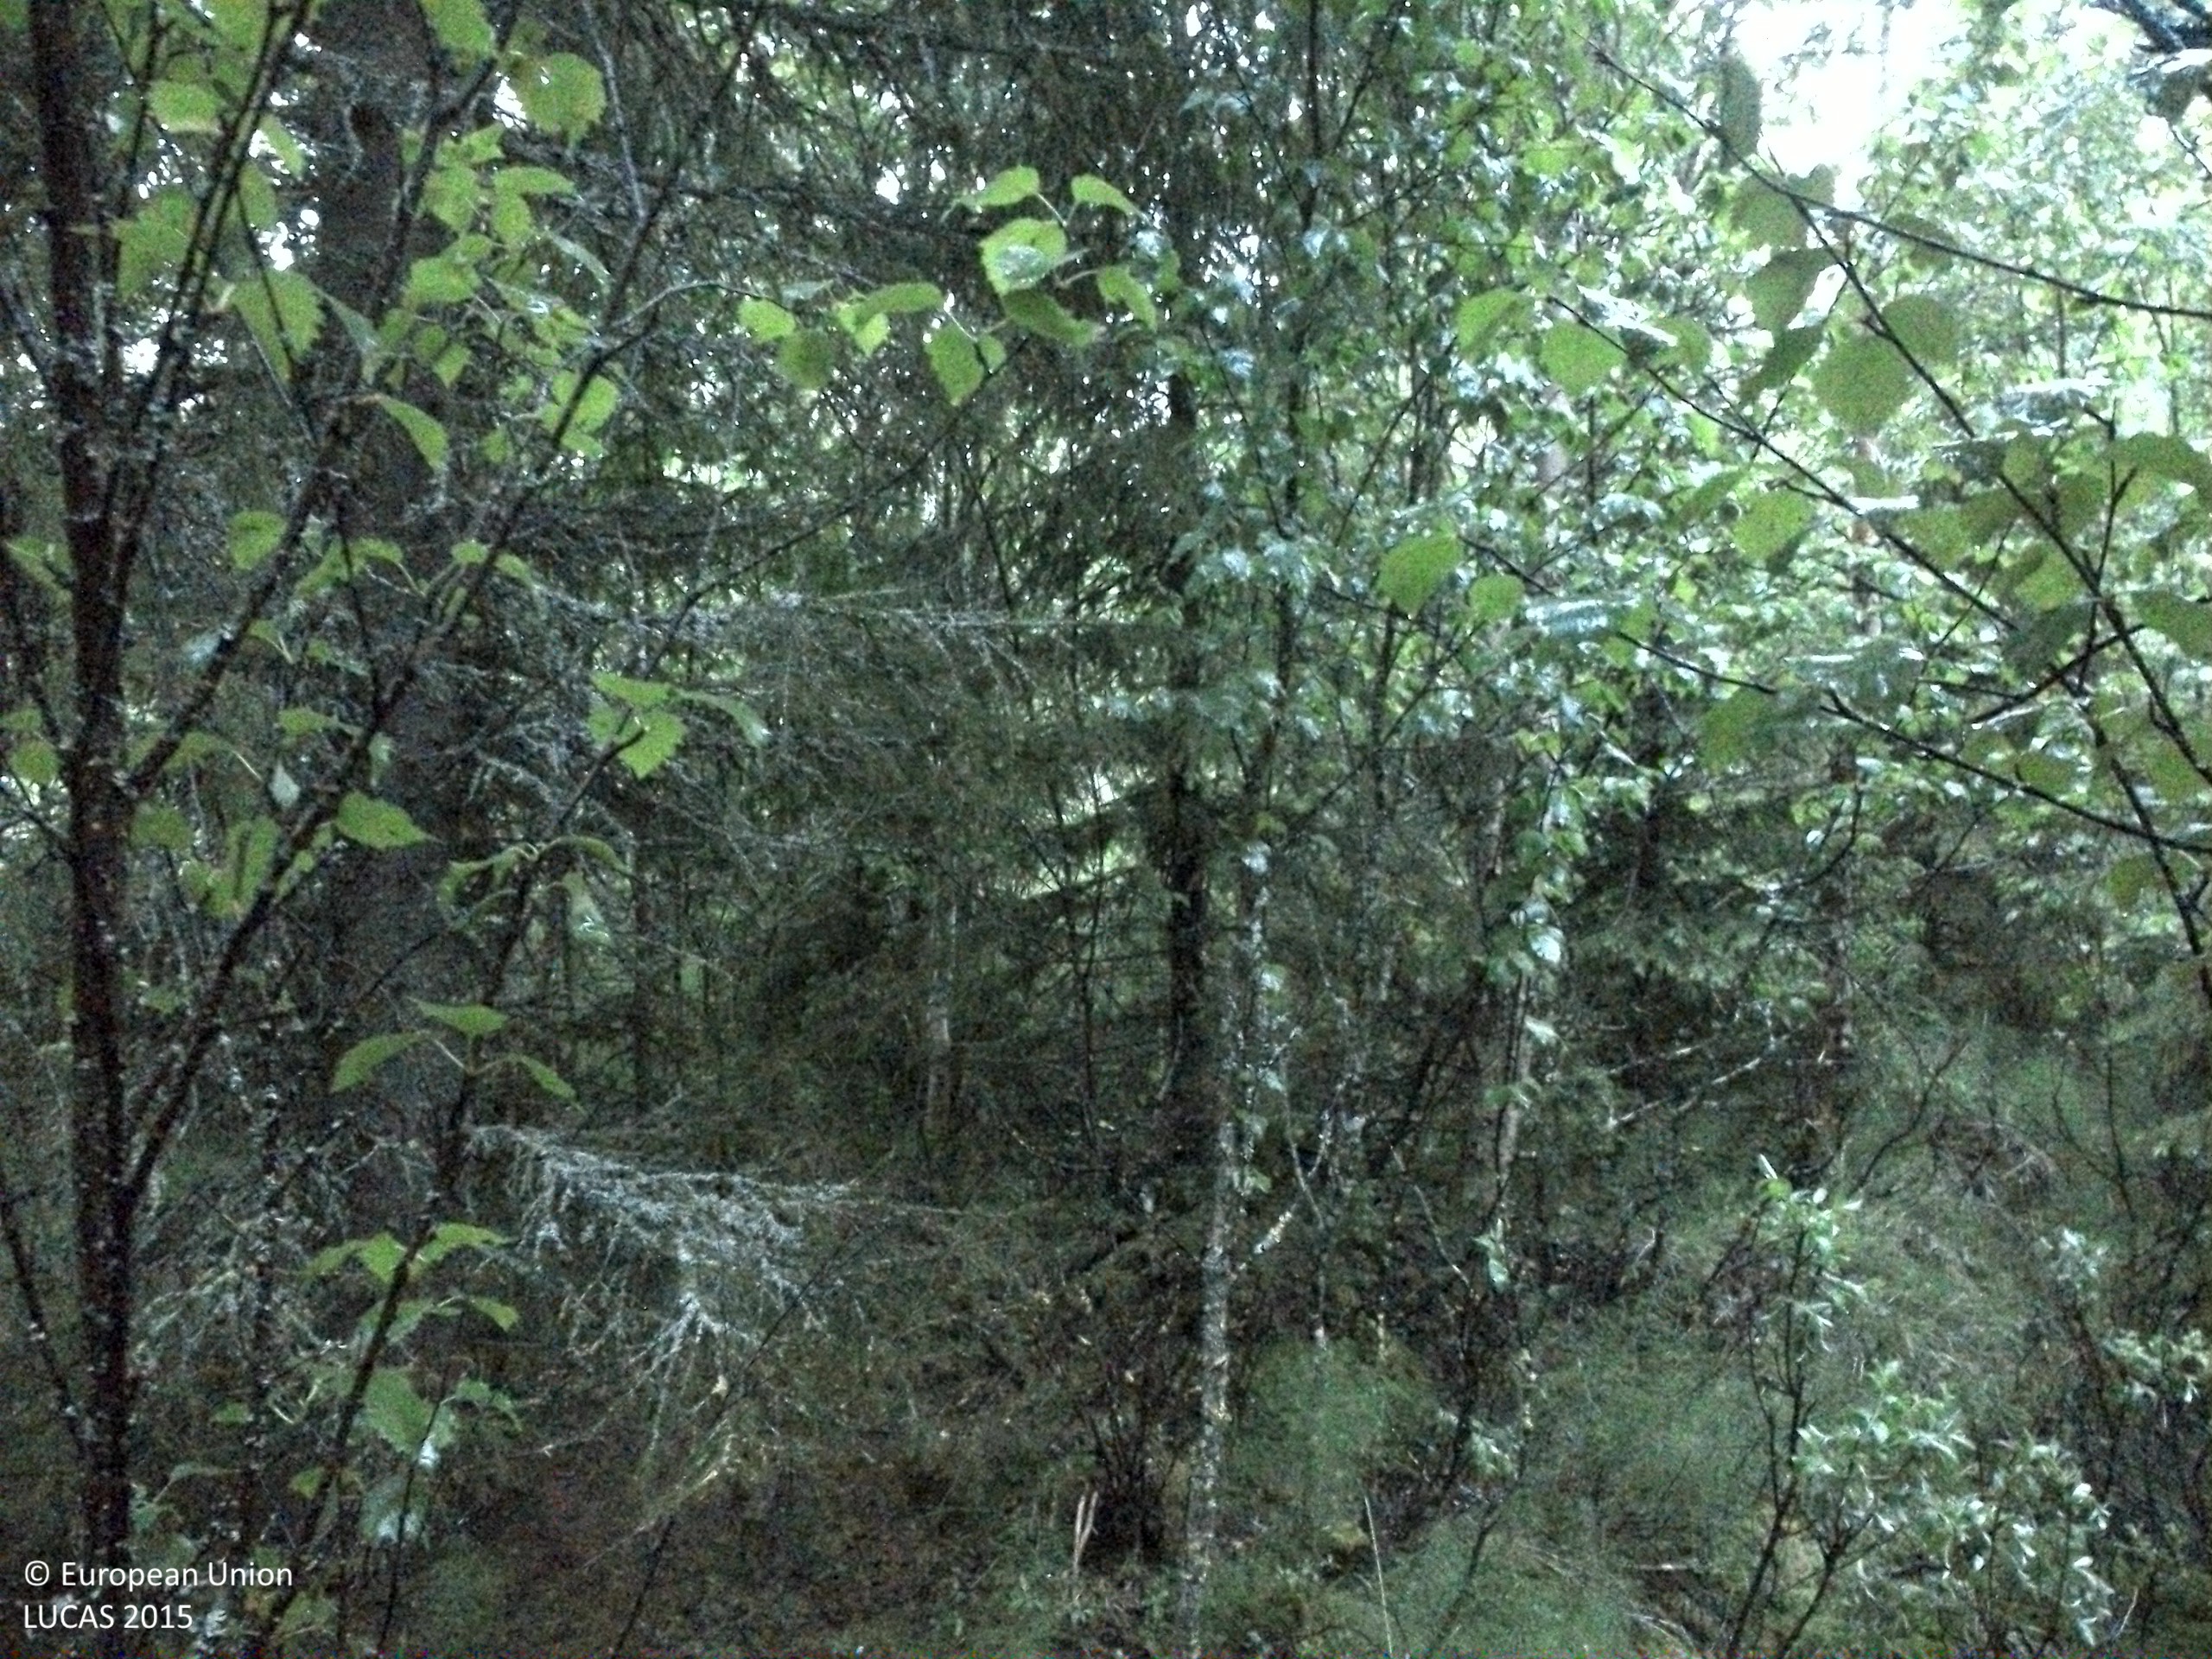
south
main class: Woodland
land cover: Other mixed woodland
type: boreal forest
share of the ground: > 75 %
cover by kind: broadleaved forest trees 45 %, coniferous forest trees 40 %, herbaceous plants 10 %, lichens and mosses 5 %
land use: Forestry
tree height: > 5 m
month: July
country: SE
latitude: 64.4784
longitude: 16.1468
